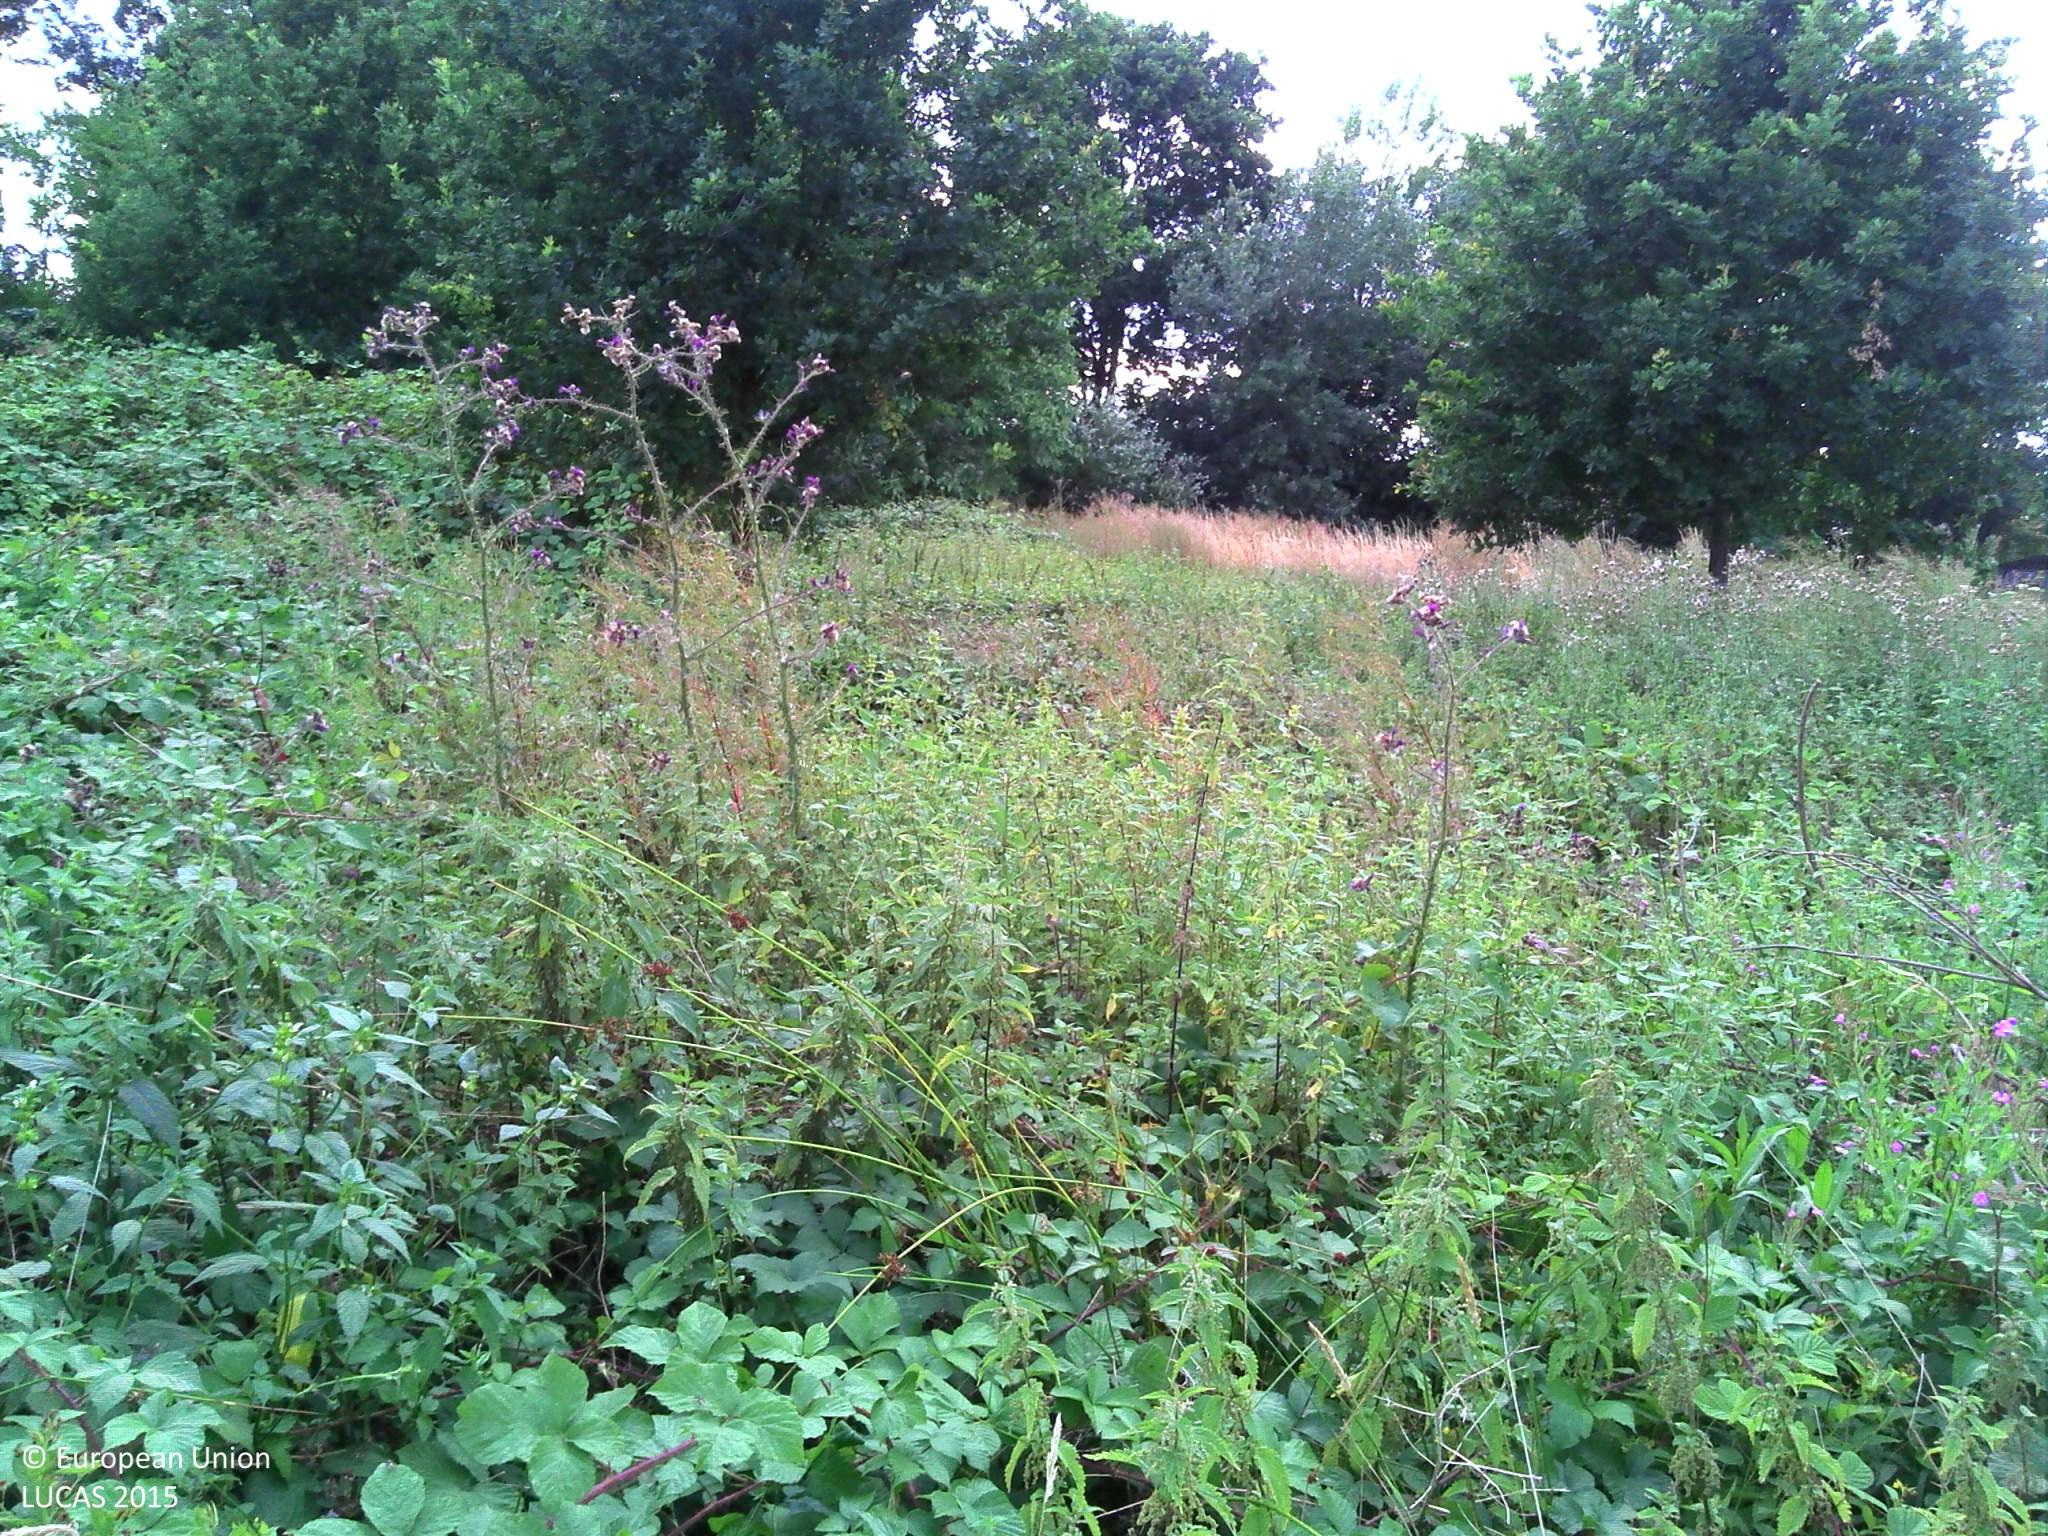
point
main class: Woodland
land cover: Broadleaved woodland
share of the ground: > 75 %
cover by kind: broadleaved forest trees 80 %, coniferous forest trees 10 %, shrubs 10 %
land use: Semi-natural and natural areas not in use
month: July
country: BE
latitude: 51.0622
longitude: 4.5309
